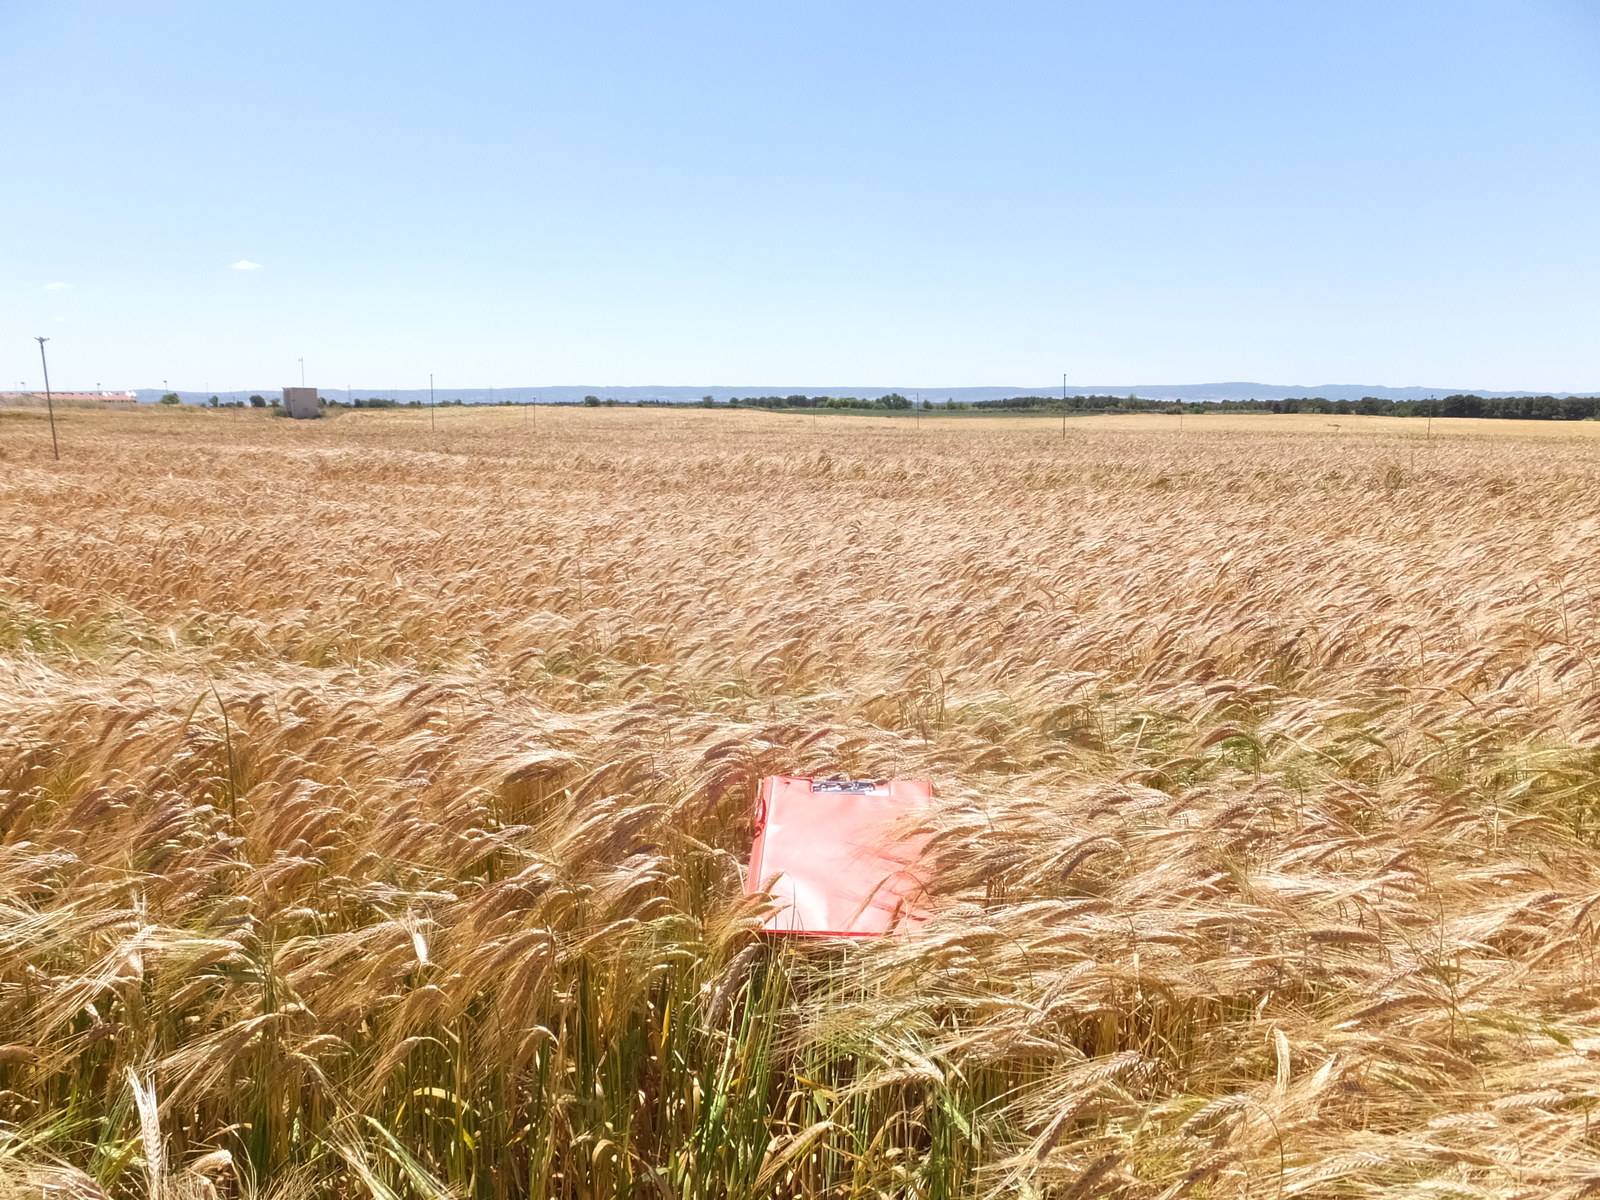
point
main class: Cropland
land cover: Barley
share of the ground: > 75 %
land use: Agriculture (excluding fallow land and kitchen gardens)
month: May
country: ES
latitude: 41.8293
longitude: -0.1929
